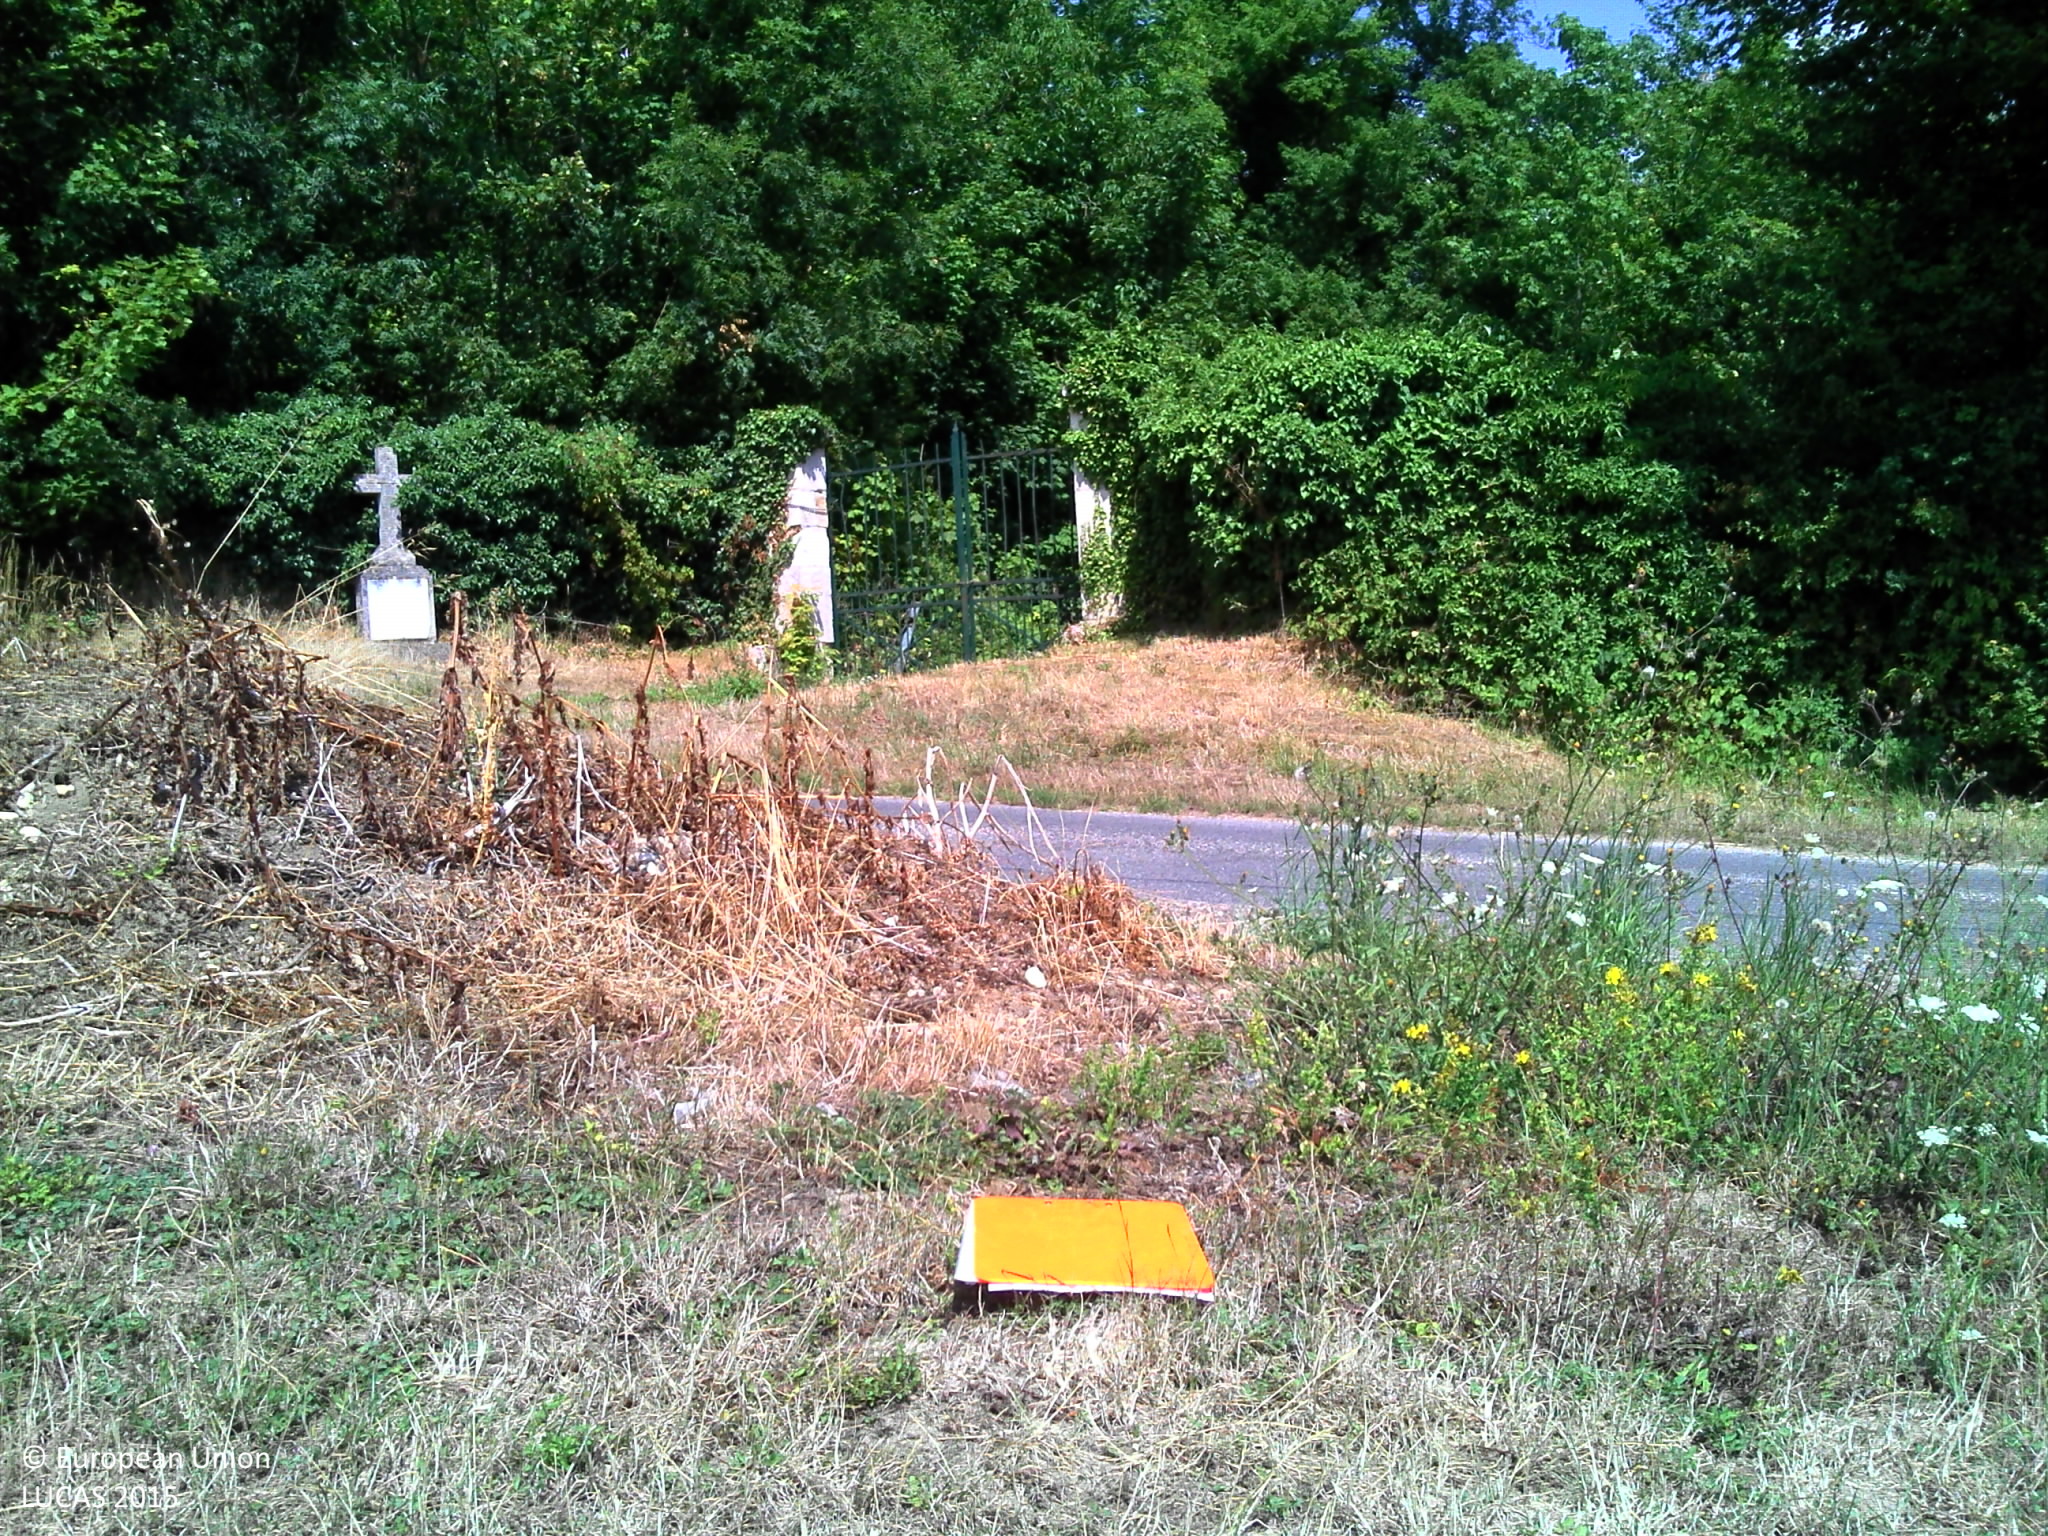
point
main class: Grassland
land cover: Grassland without tree/shrub cover
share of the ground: > 75 %
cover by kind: herbaceous plants 85 %, consolidated bare surface 5 %, unconsolidated bare surface 5 %
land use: Semi-natural and natural areas not in use
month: August
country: FR
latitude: 49.1099
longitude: 3.7336
